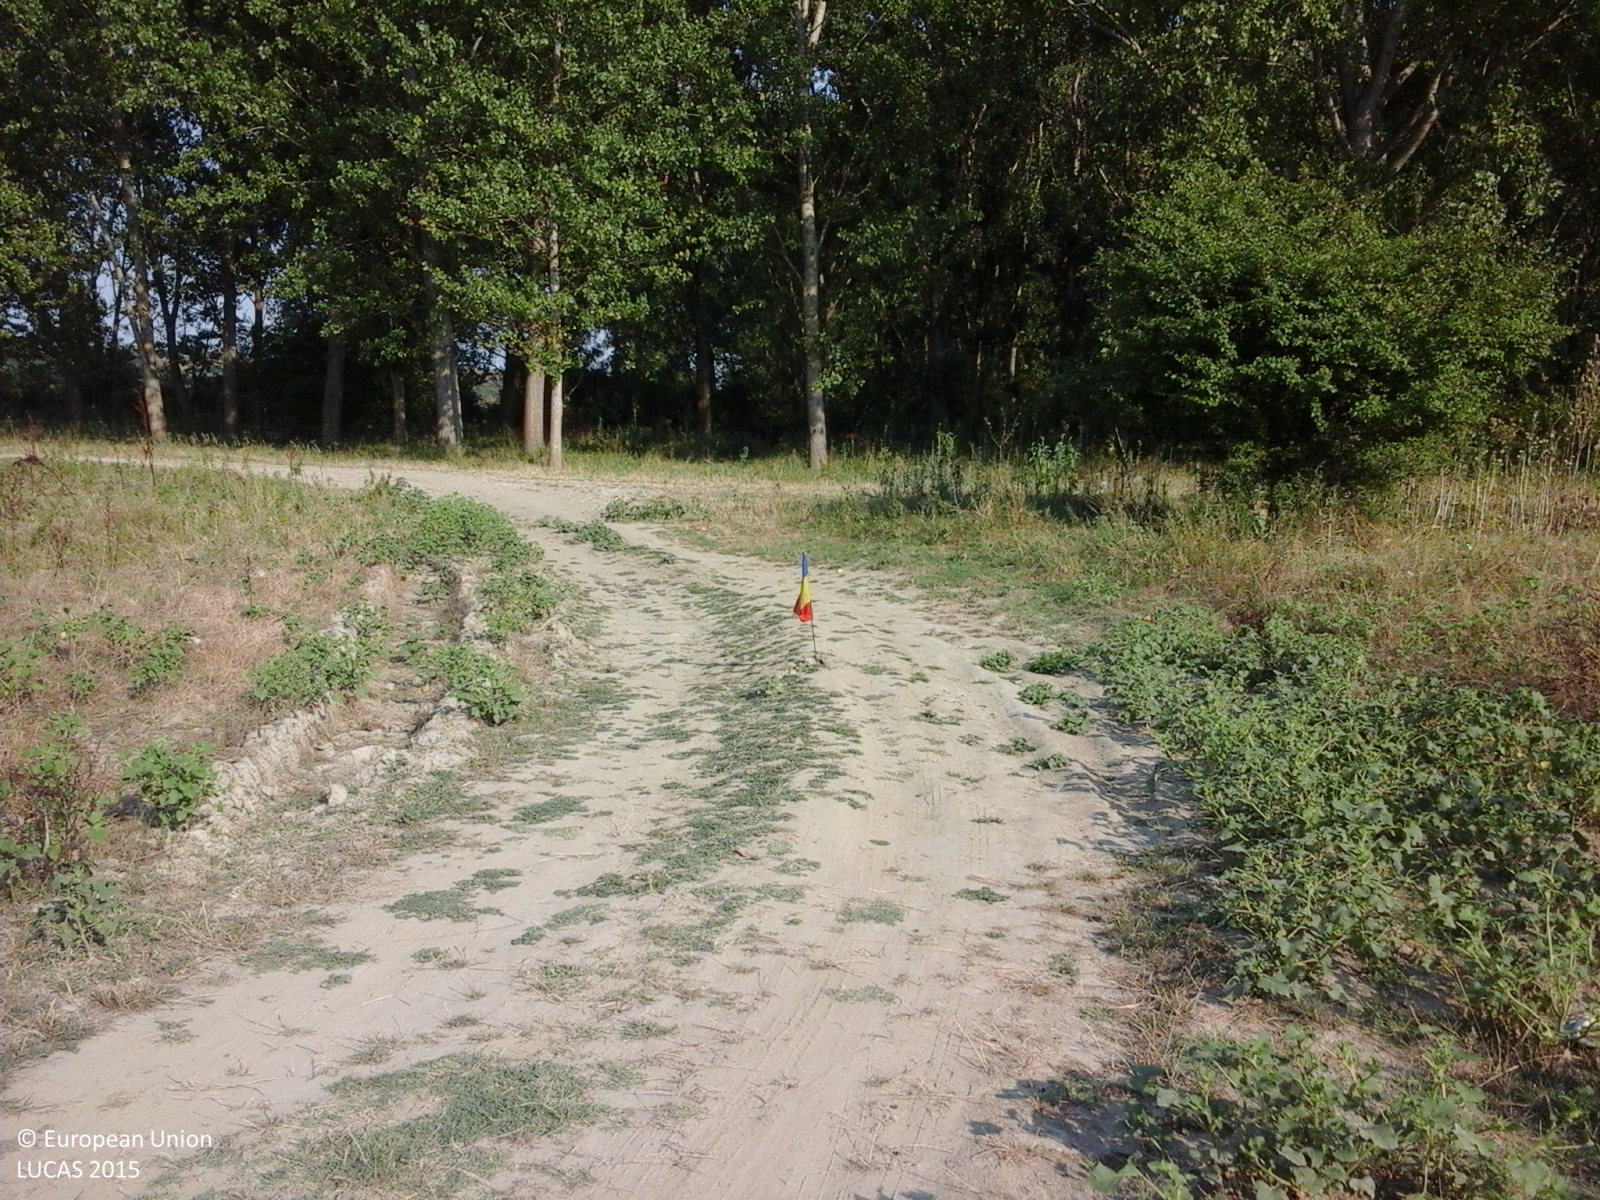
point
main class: Grassland
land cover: Spontaneously vegetated surfaces
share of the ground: > 75 %
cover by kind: herbaceous plants 100 %
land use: Fallow land
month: August
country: RO
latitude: 44.4919
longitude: 23.5984
